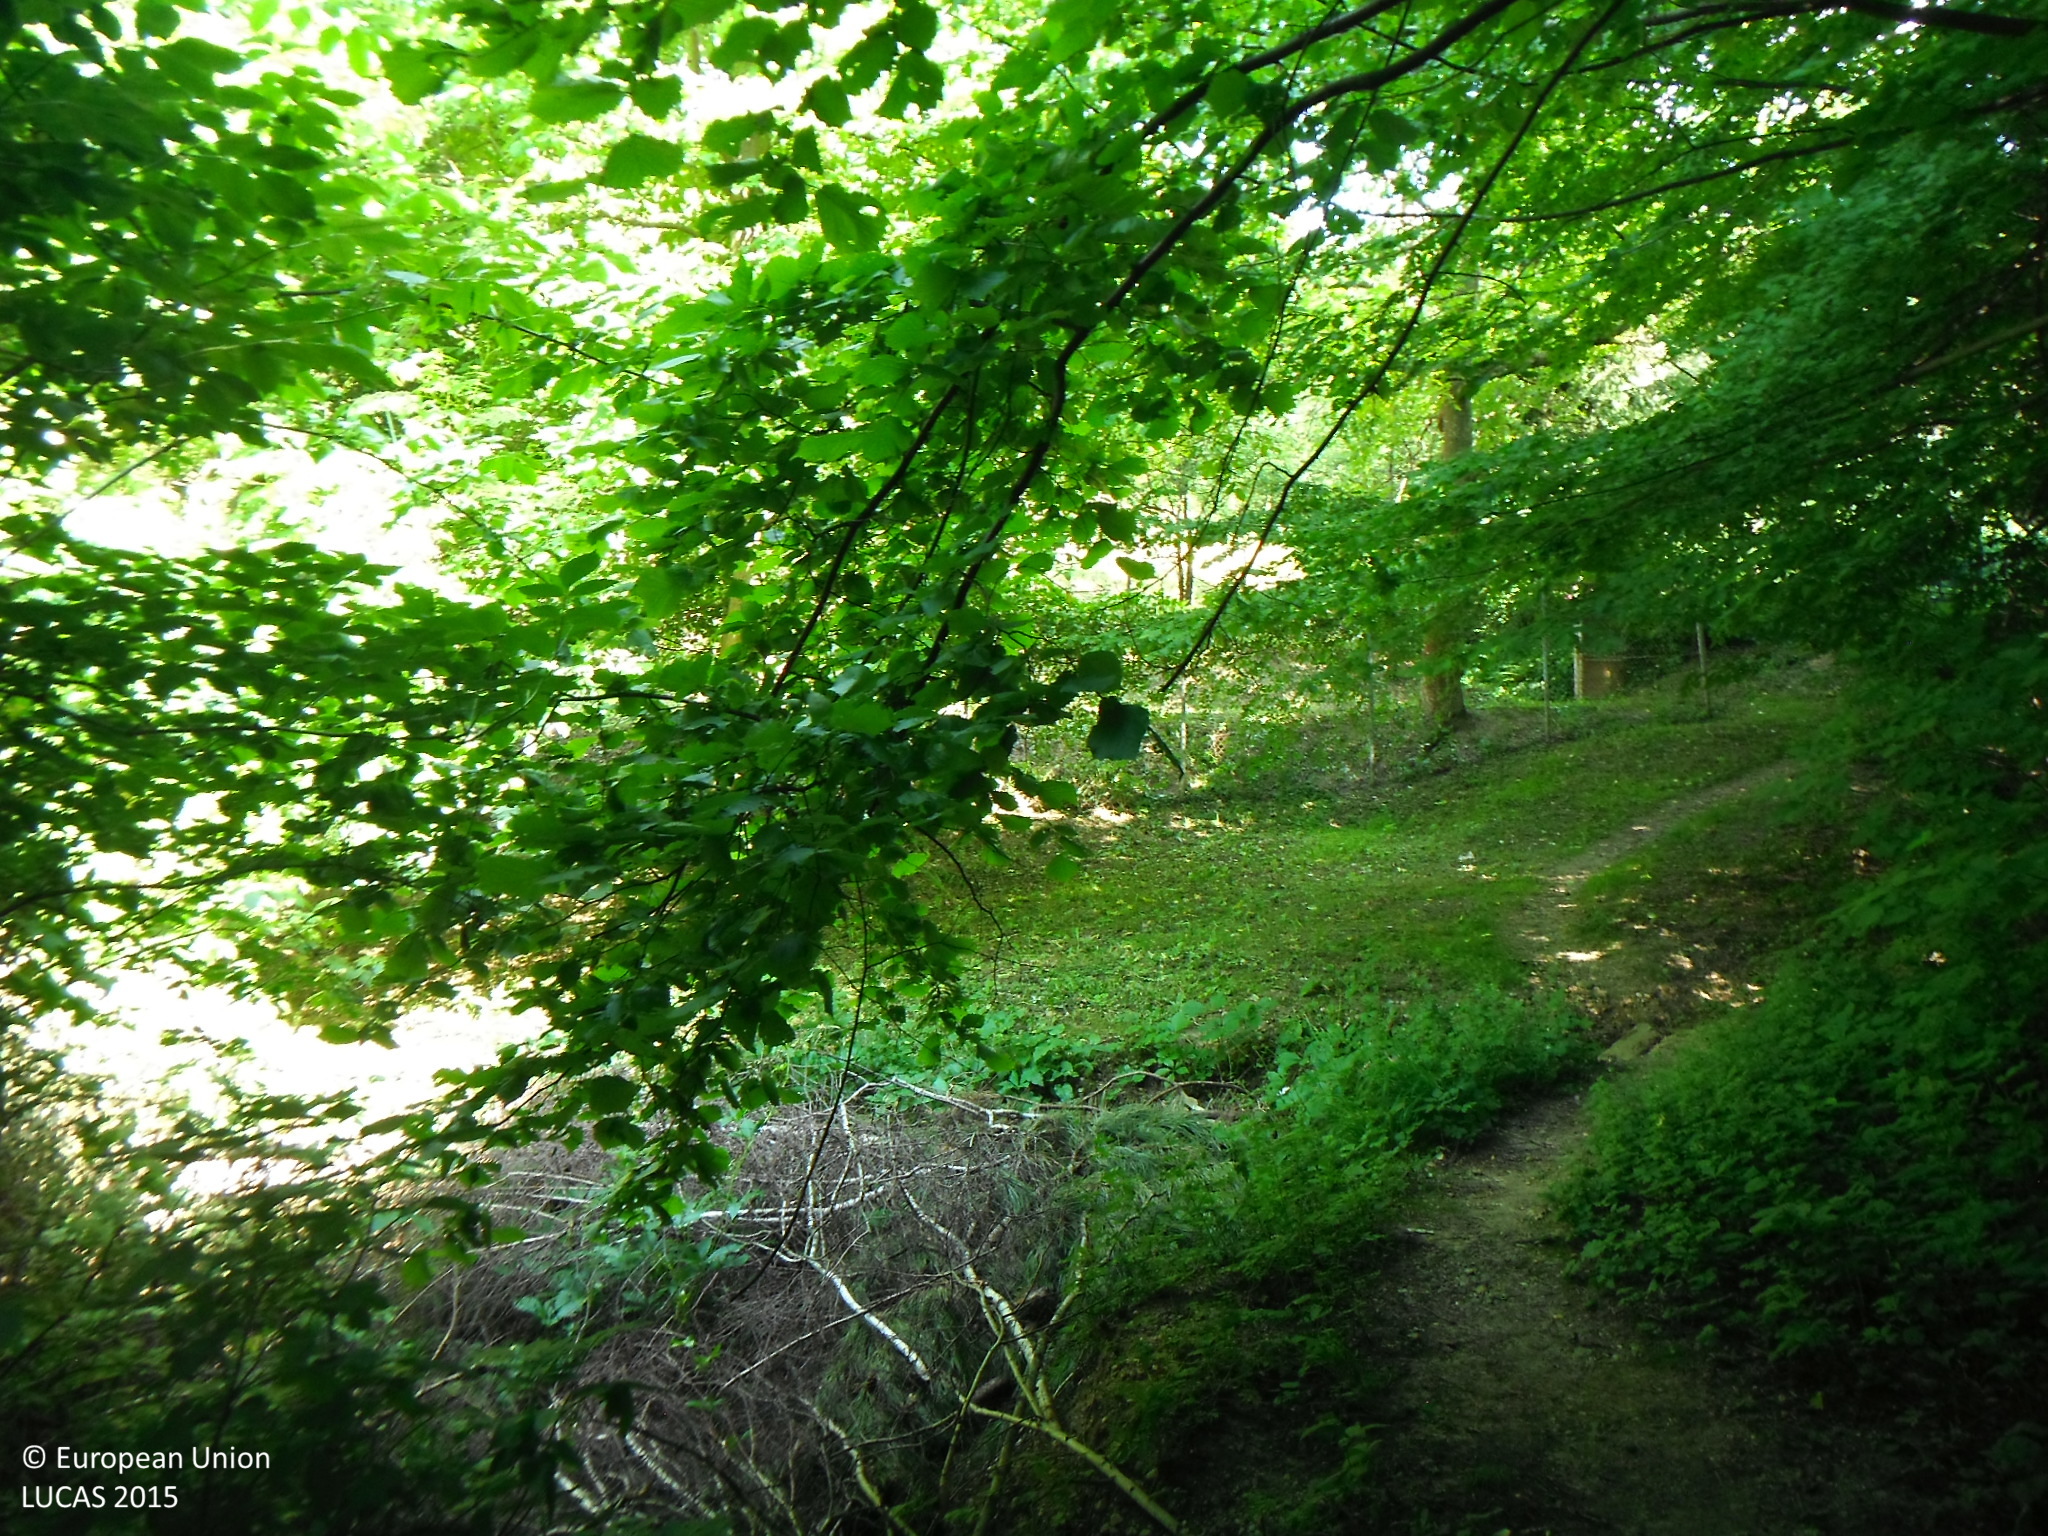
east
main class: Woodland
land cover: Broadleaved woodland
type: mesophytic deciduous forest
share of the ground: > 75 %
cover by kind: broadleaved forest trees 80 %, shrubs 20 %
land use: Semi-natural and natural areas not in use
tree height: > 5 m
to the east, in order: Broadleaved woodland; Artificial constructions in urban areas; Grass margins; Tracks; Shrubland without tree cover; Spontaneously vegetated surfaces; Broadleaved woodland; Grassland without tree/shrub cover
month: June
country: SK
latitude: 48.7139
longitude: 21.2846
